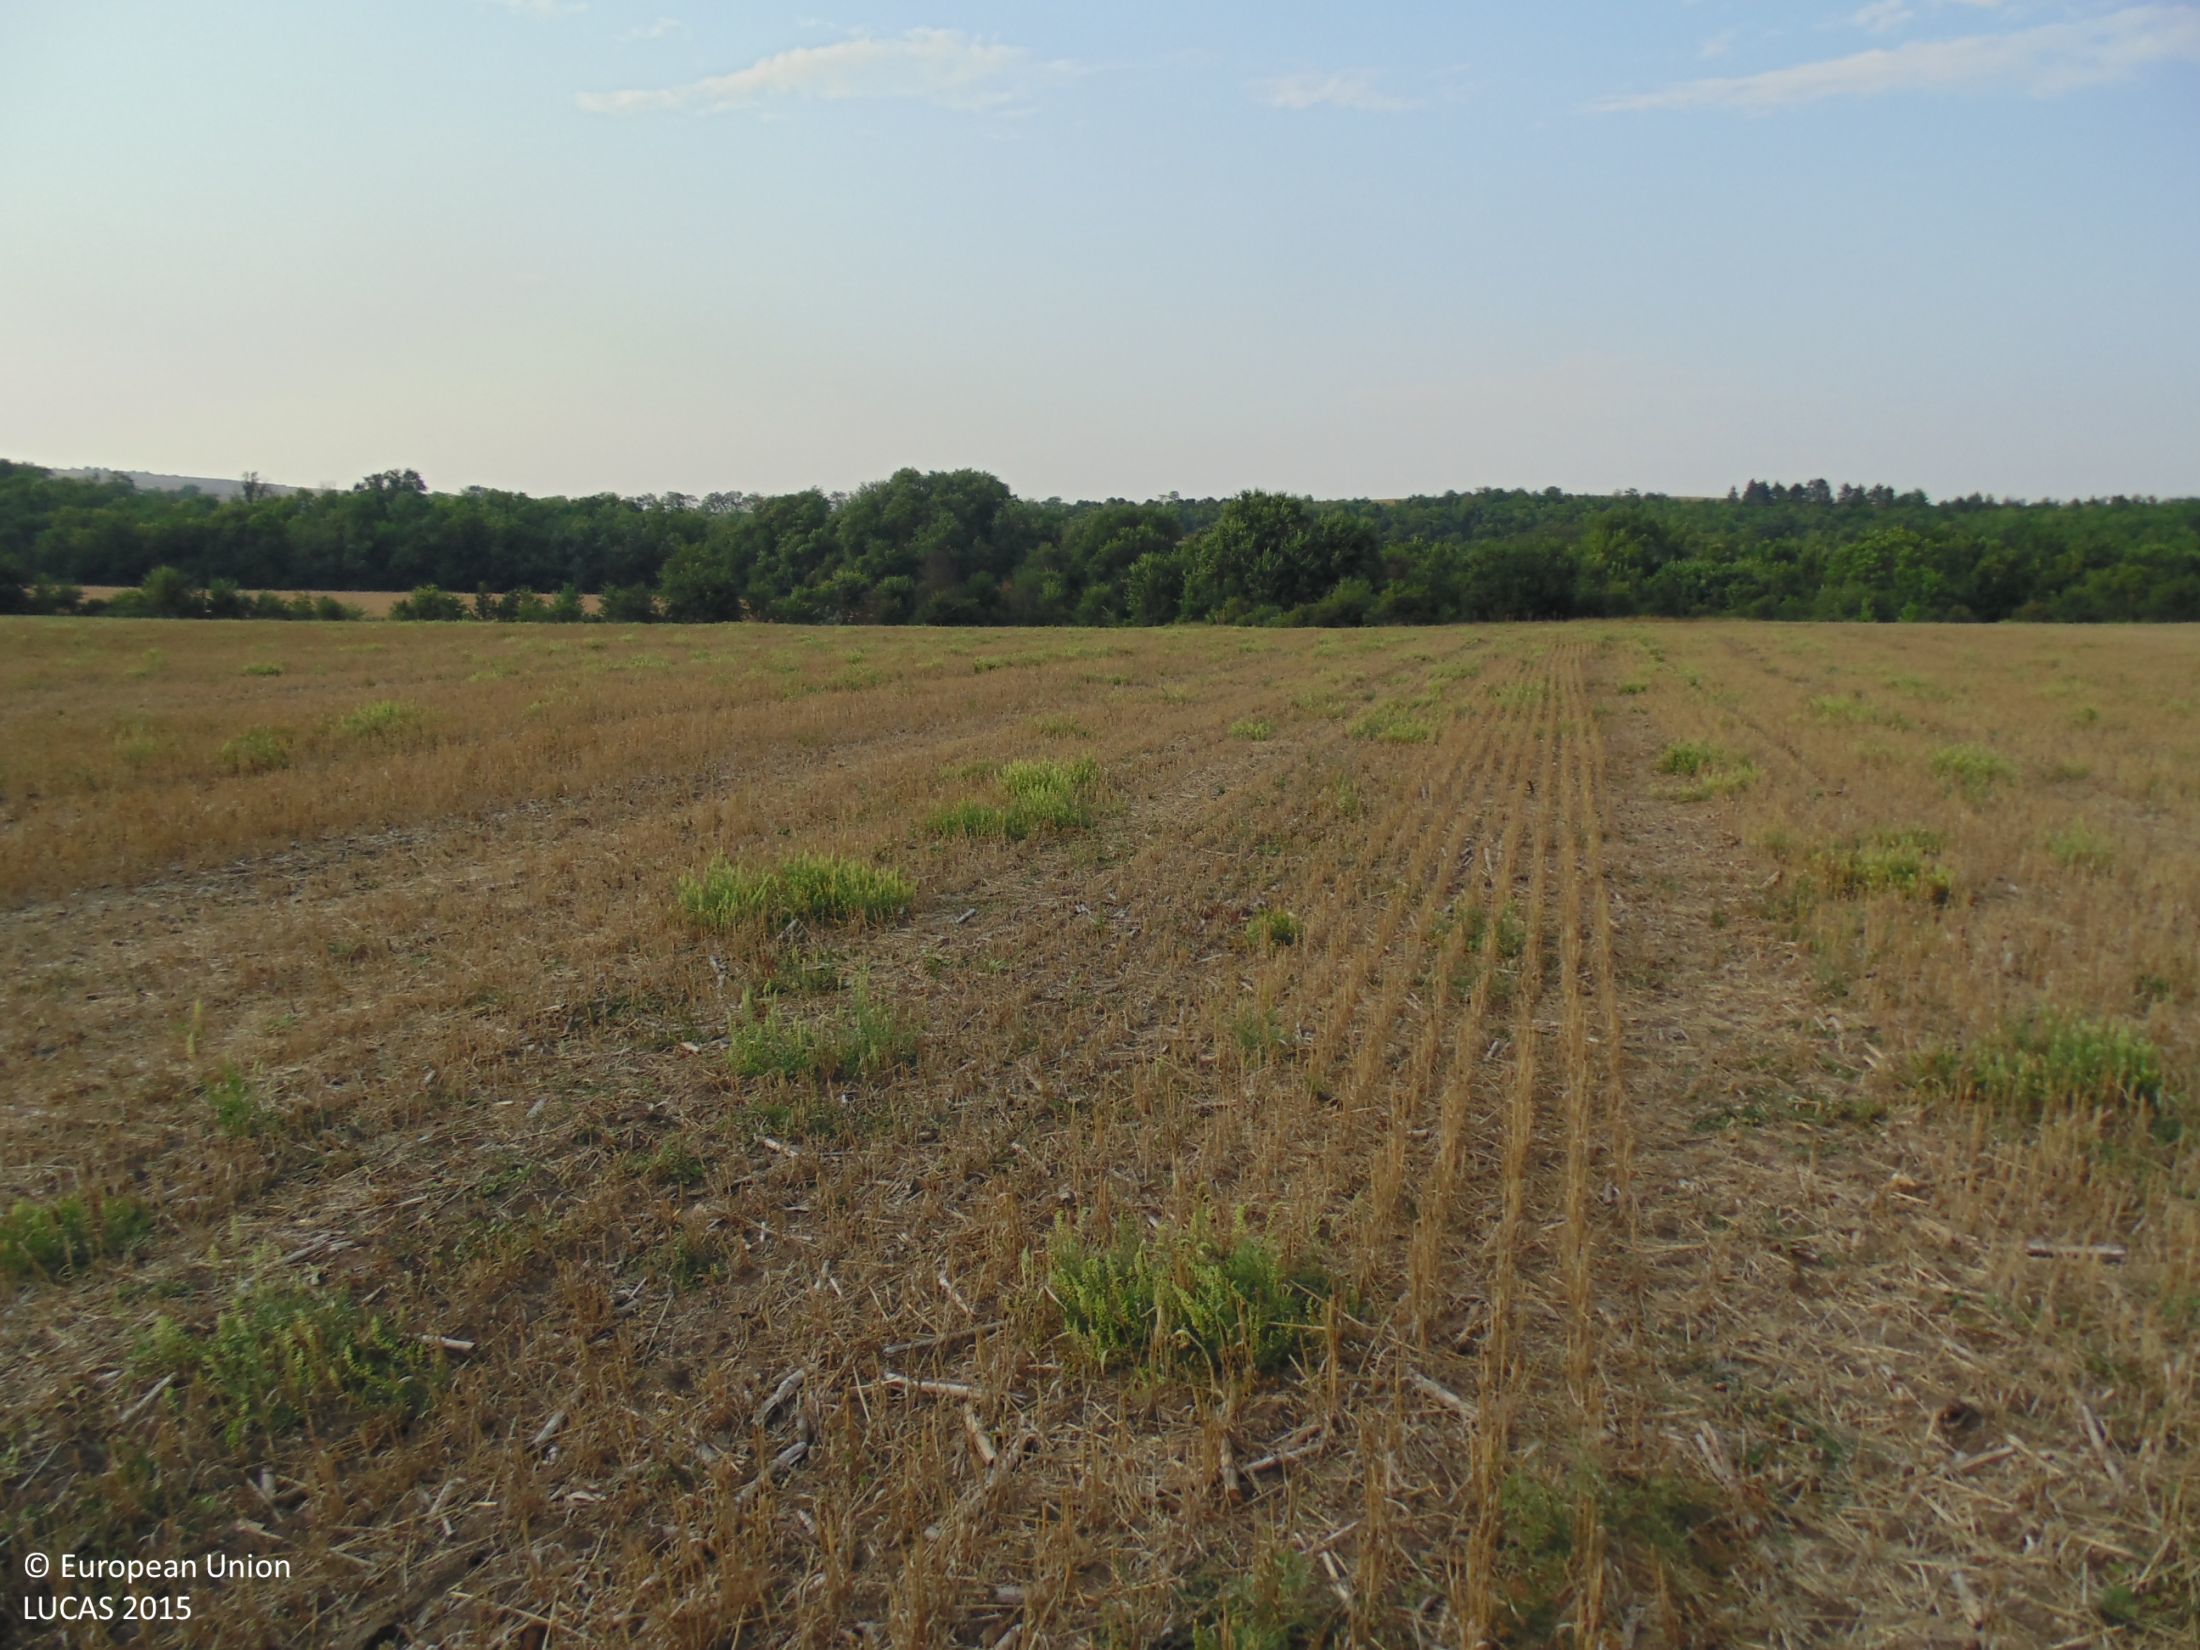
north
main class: Cropland
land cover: Common wheat
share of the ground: 25 - 50 %
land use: Agriculture (excluding fallow land and kitchen gardens)
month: August
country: BG
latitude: 43.6246
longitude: 27.5971
